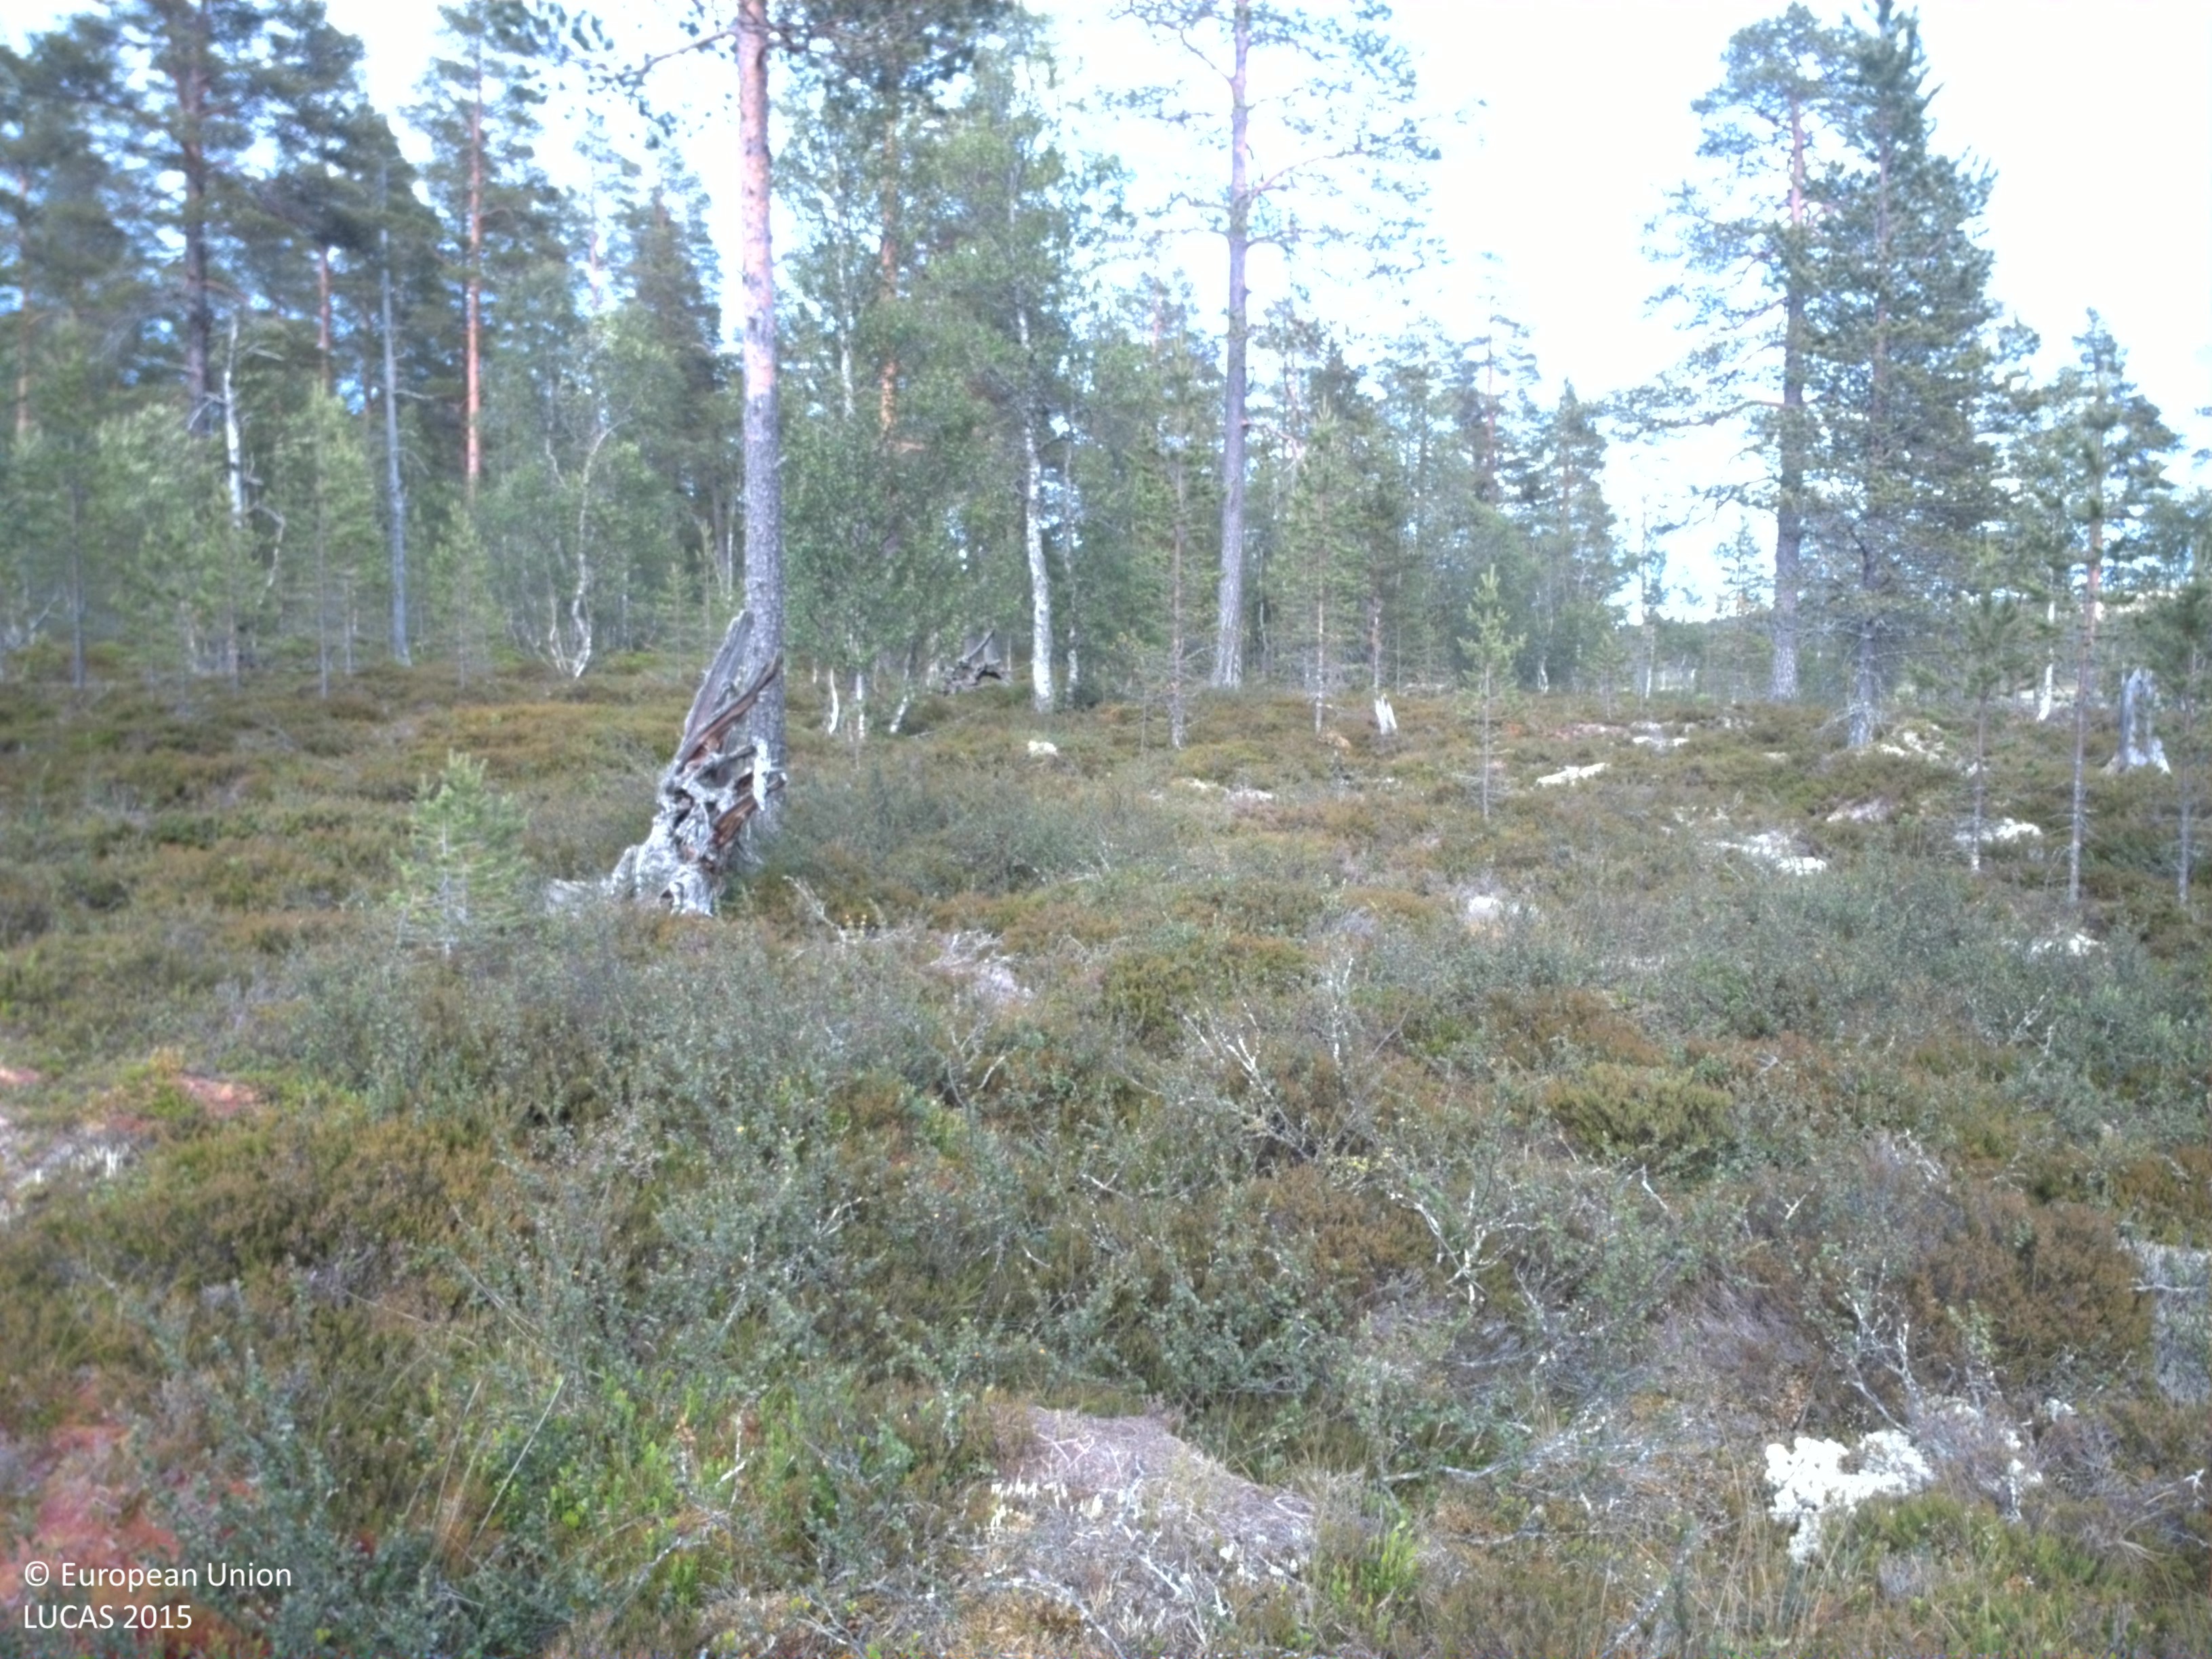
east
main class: Woodland
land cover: Pine dominated coniferous woodland
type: boreal forest
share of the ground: 10 - 25 %
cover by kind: shrubs 40 %, lichens and mosses 35 %, coniferous forest trees 15 %, herbaceous plants 10 %
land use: Forestry
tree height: < 5 m
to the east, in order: Pine dominated coniferous woodland; Other mixed woodland
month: July
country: SE
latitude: 61.5944
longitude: 13.6236
